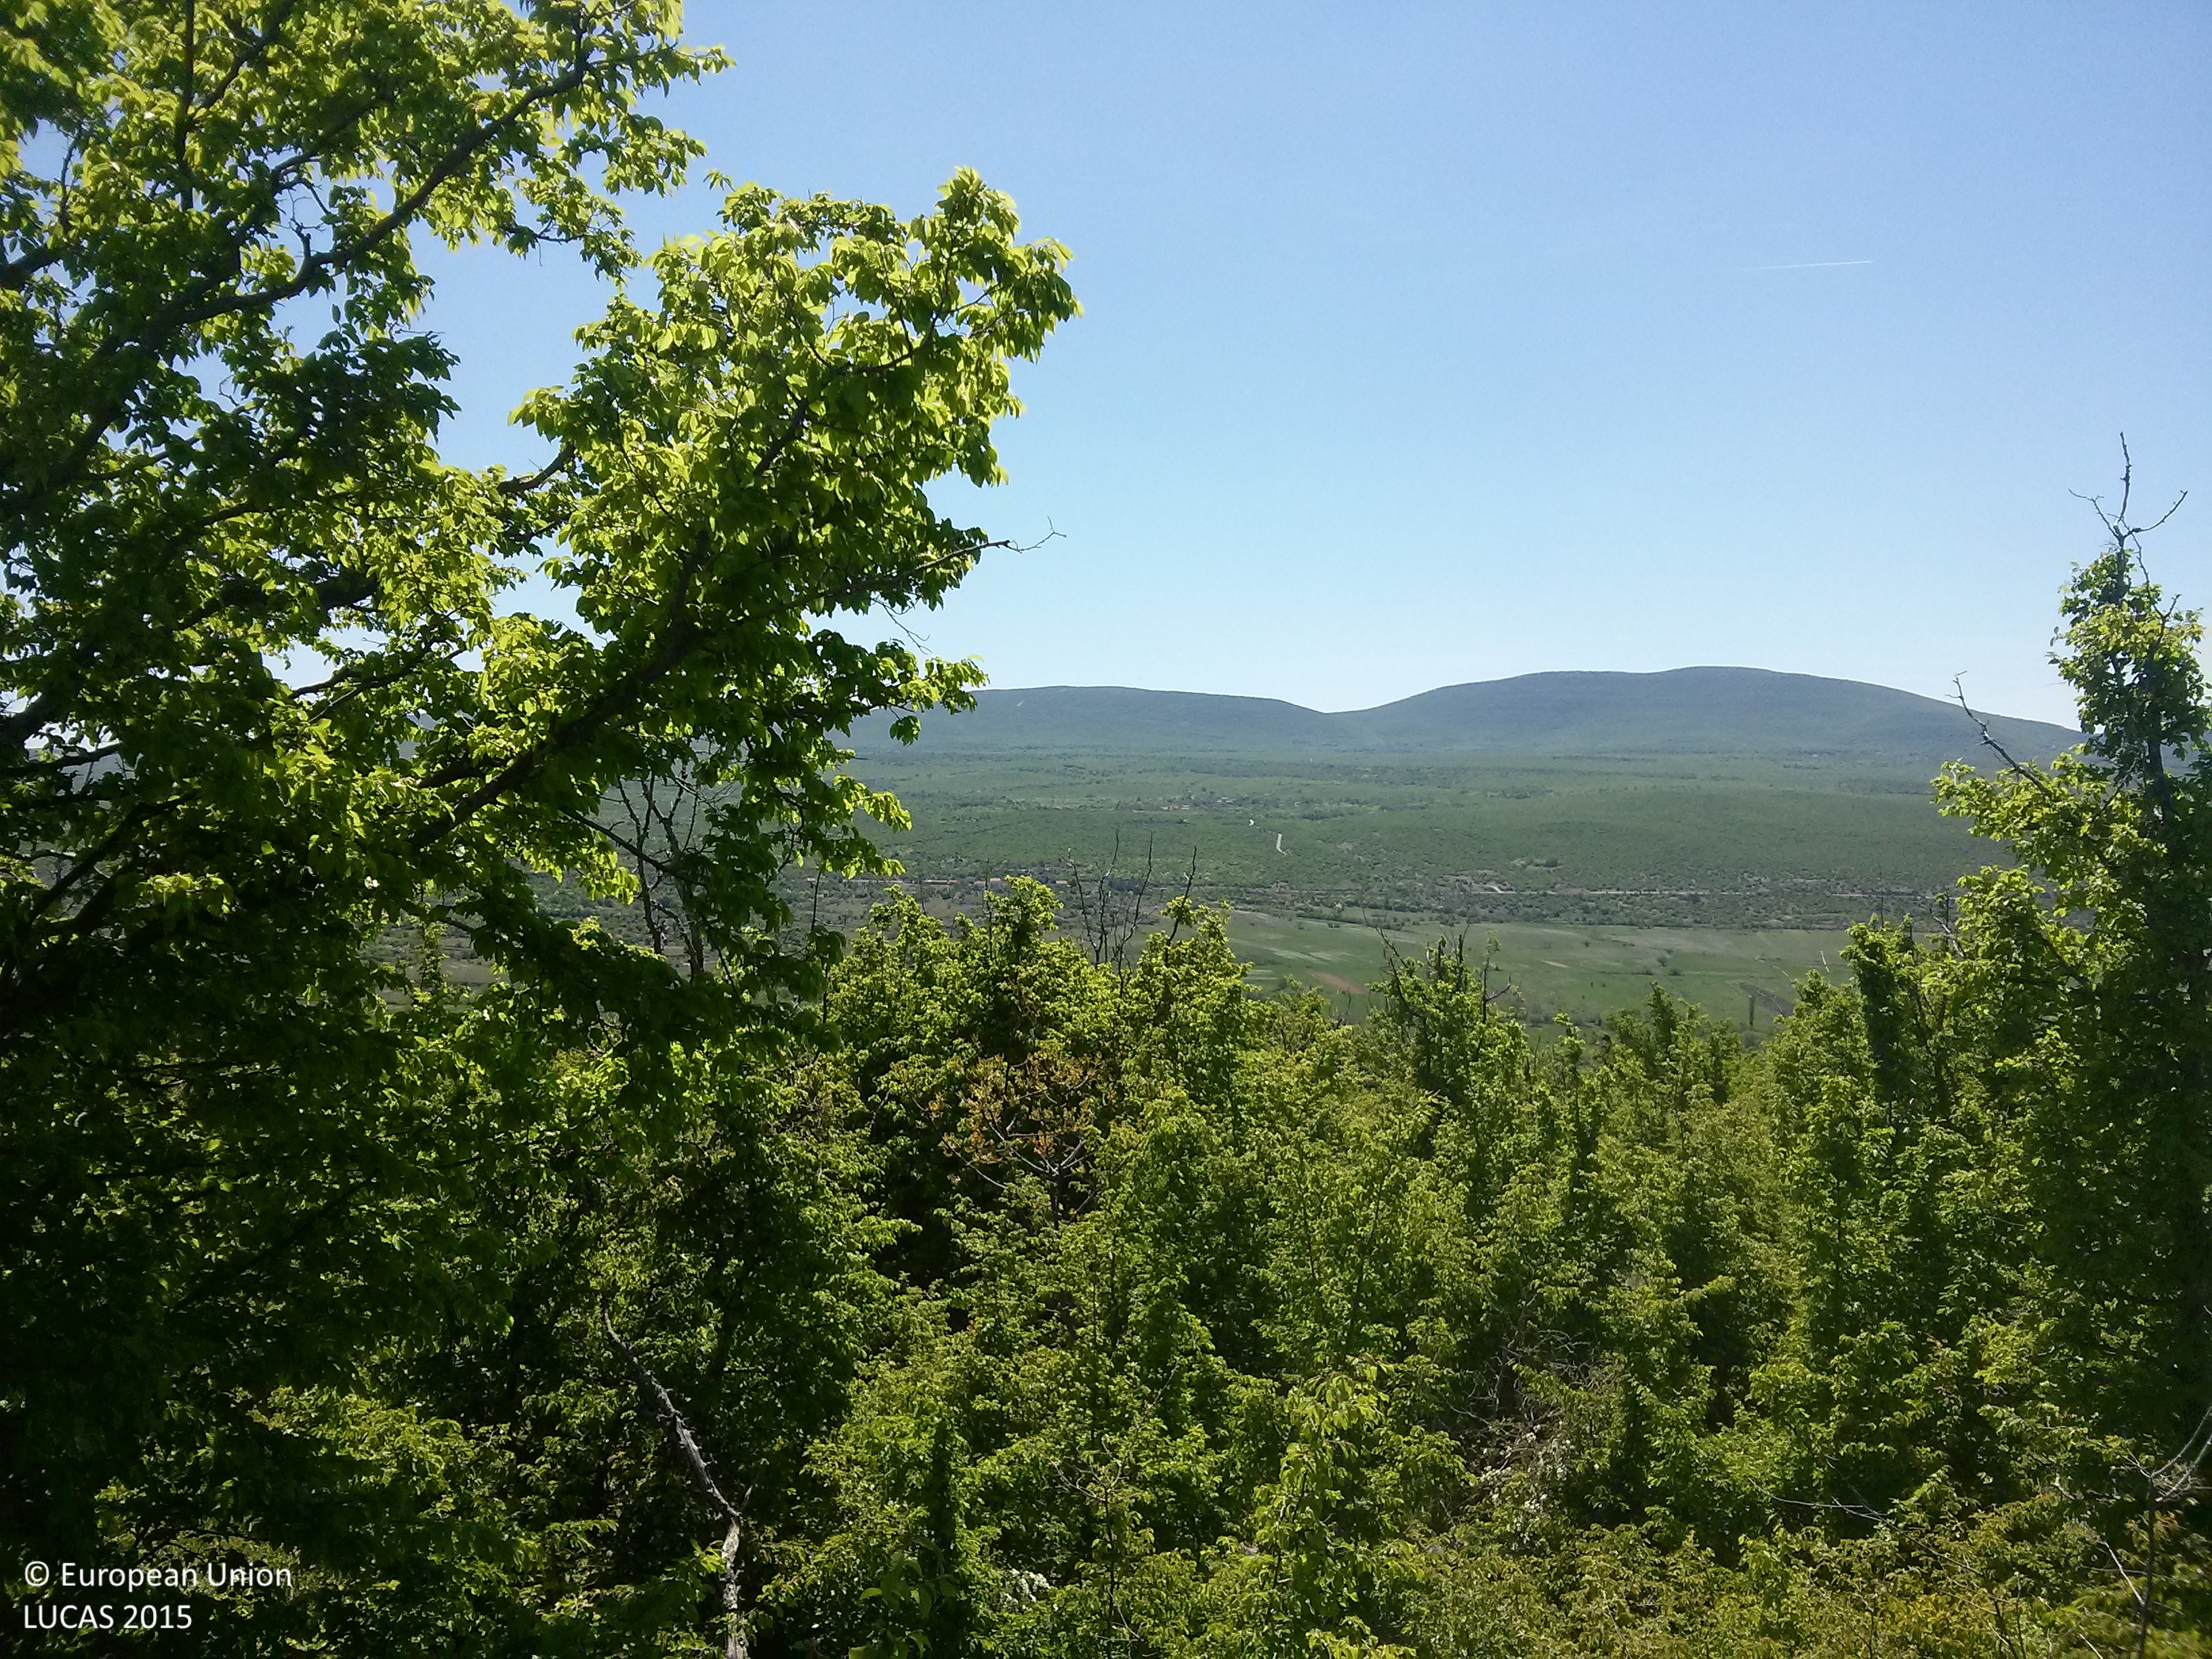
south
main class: Woodland
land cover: Broadleaved woodland
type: thermophilous deciduous forest
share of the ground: > 75 %
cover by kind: broadleaved forest trees 90 %, herbaceous plants 5 %, unconsolidated bare surface 5 %
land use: Semi-natural and natural areas not in use
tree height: < 5 m
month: April
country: HR
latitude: 44.1656
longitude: 15.8828
